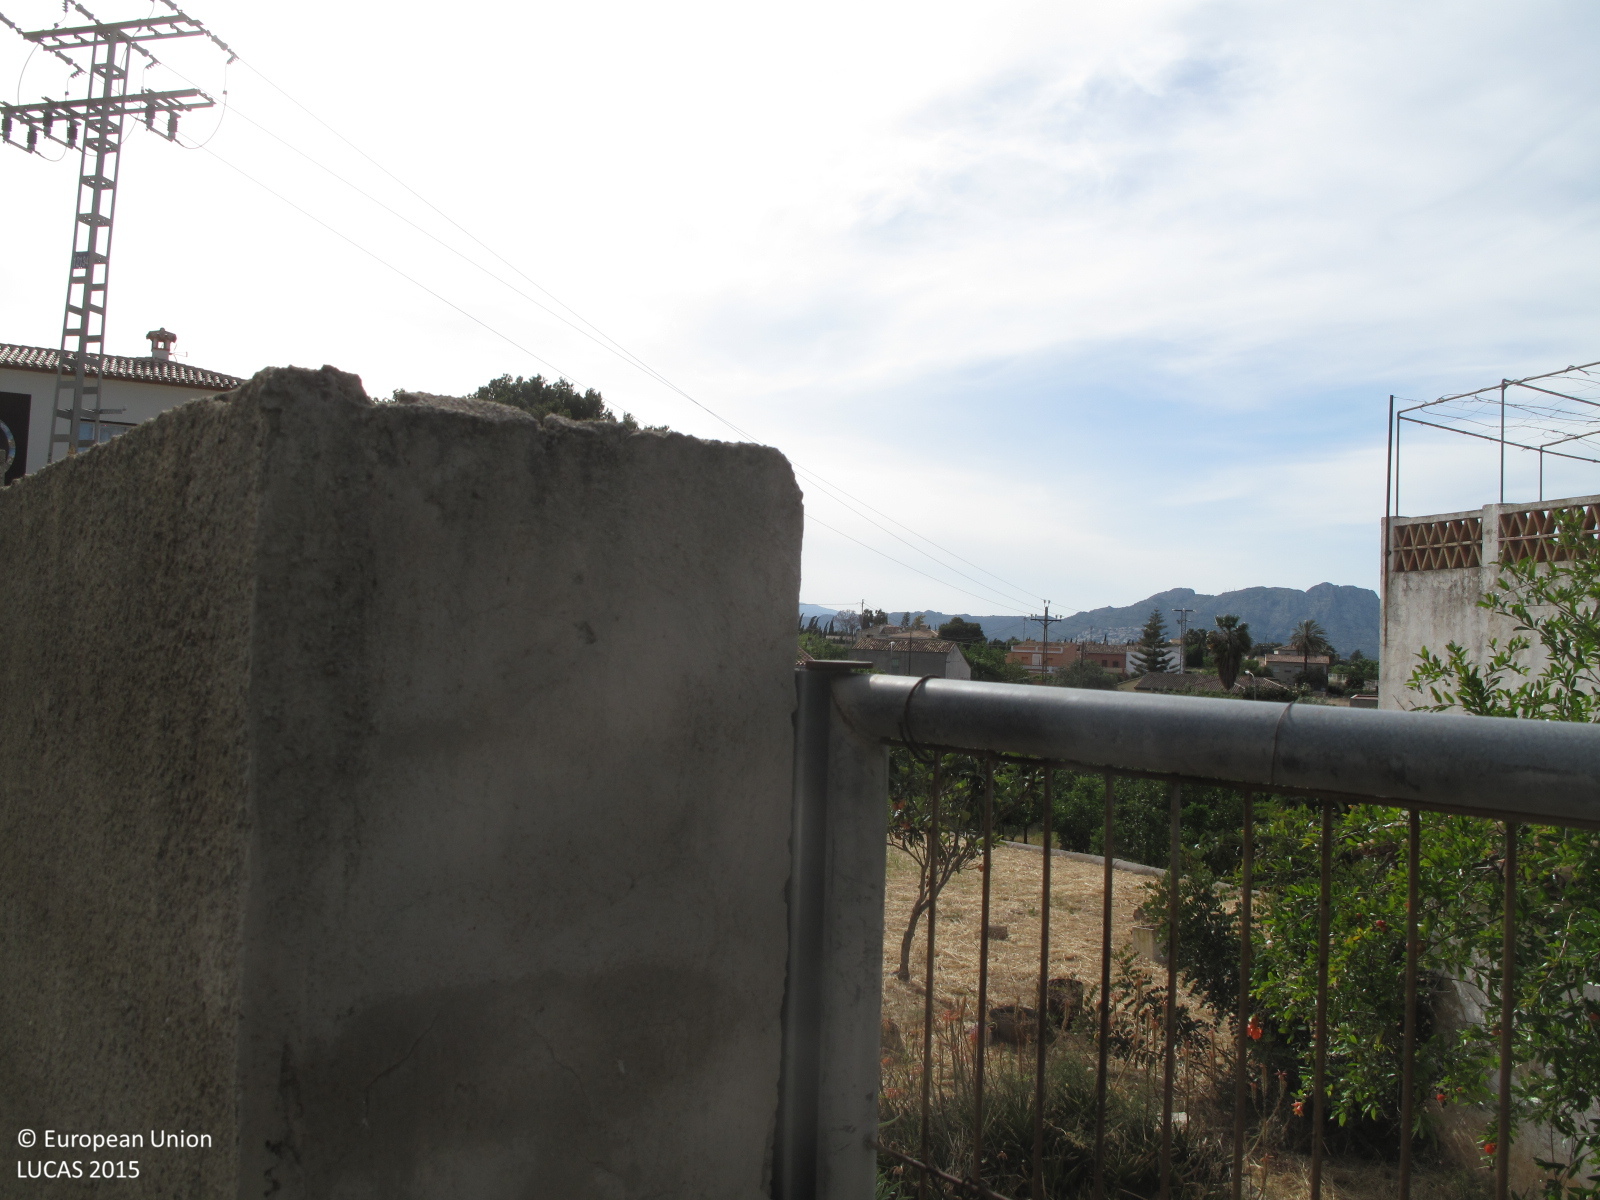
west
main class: Grassland
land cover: Grassland with sparse tree/shrub cover
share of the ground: > 75 %
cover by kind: herbaceous plants 95 %, broadleaved forest trees 5 %
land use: Residential
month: May
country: ES
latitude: 38.7920
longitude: 0.0296
